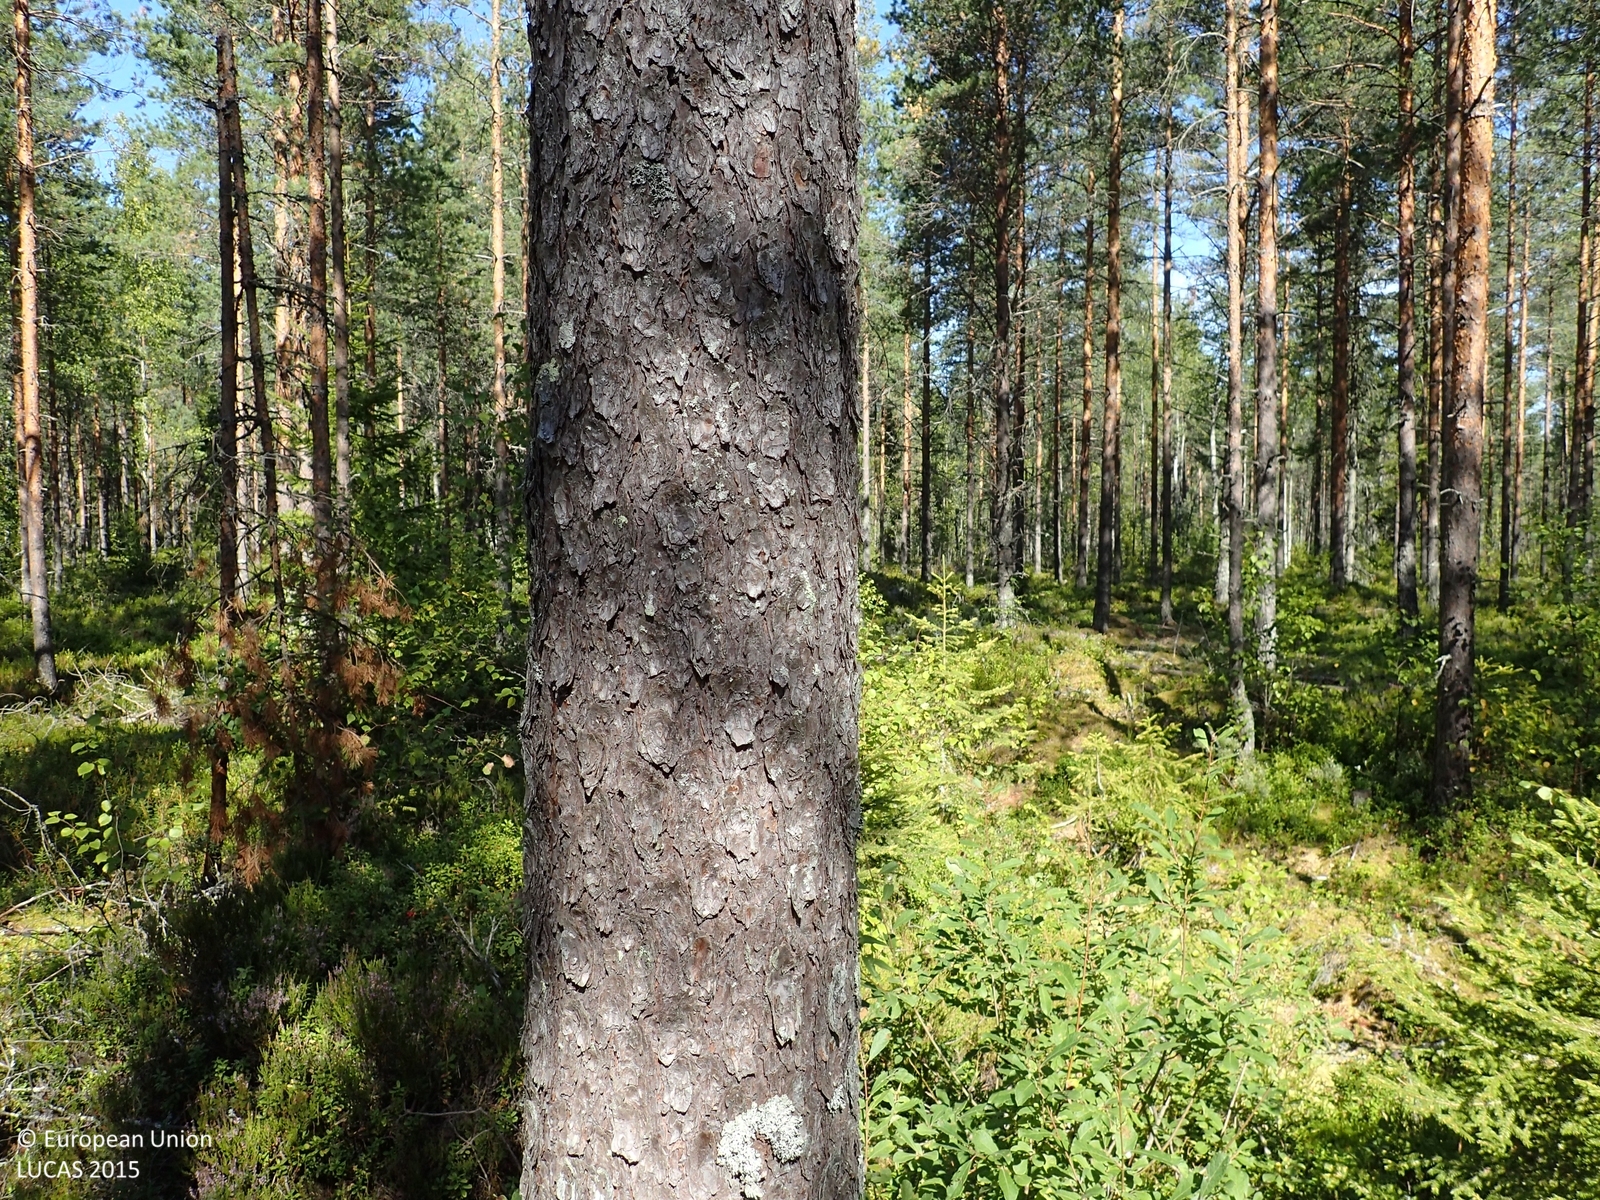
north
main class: Woodland
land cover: Pine dominated coniferous woodland
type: boreal forest
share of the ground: 50 - 75 %
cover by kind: coniferous forest trees 60 %, shrubs 25 %, broadleaved forest trees 10 %, lichens and mosses 5 %
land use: Forestry
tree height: > 5 m
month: August
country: FI
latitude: 62.5919
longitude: 21.9455
